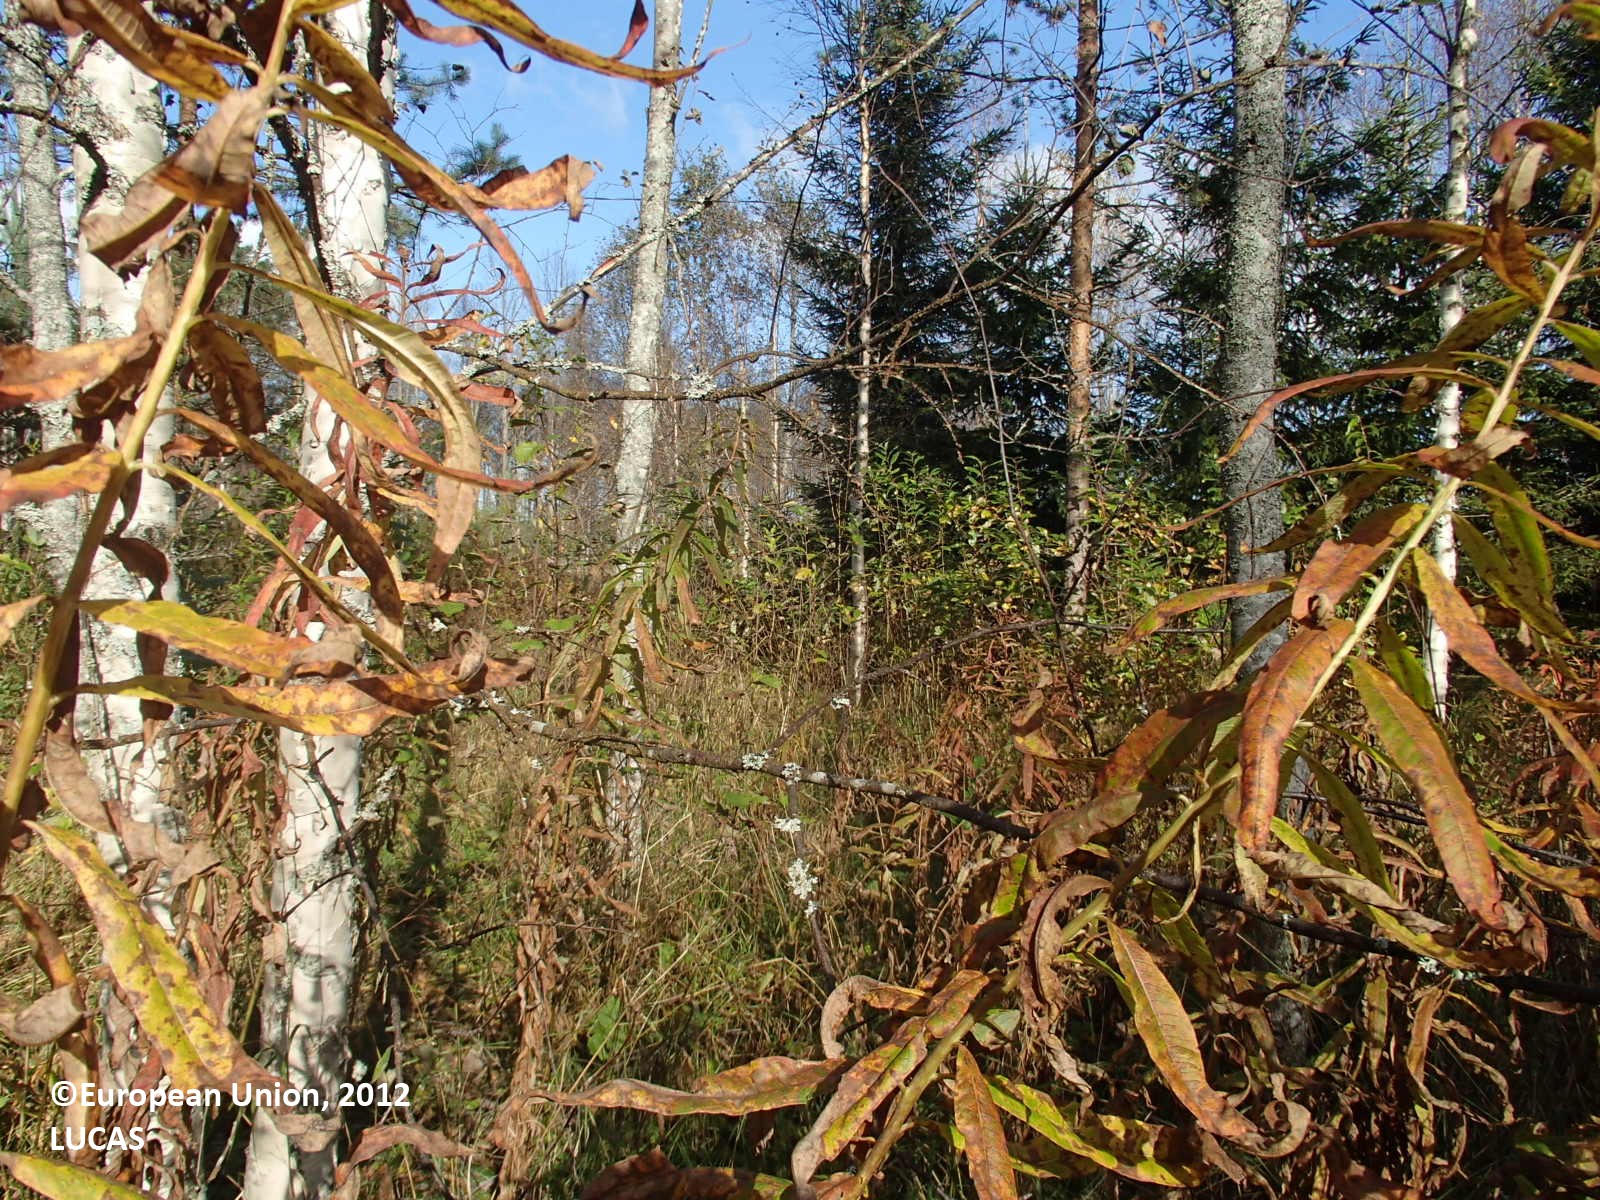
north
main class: Woodland
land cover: Other mixed woodland
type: boreal forest
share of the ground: > 75 %
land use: Forestry
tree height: > 5 m
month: September
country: FI
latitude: 63.6610
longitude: 26.0935
